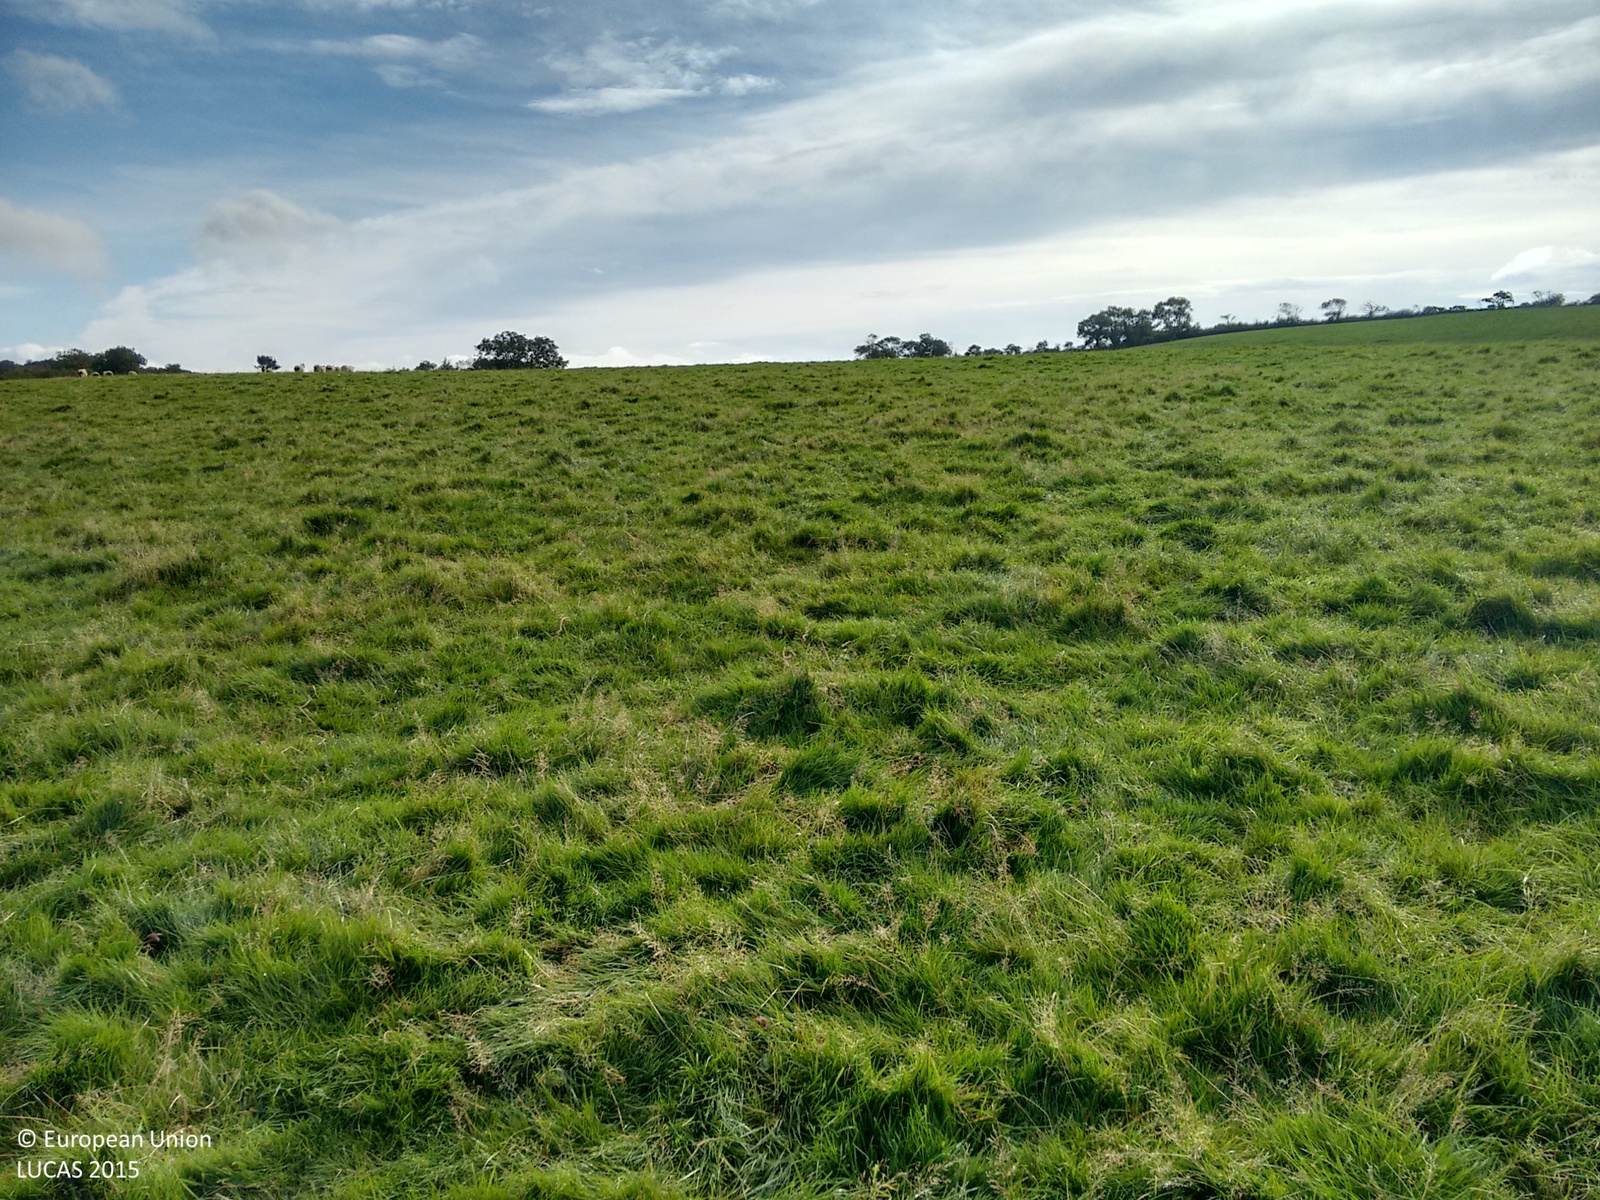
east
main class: Grassland
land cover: Grassland without tree/shrub cover
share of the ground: > 75 %
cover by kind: herbaceous plants 100 %
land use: Agriculture (excluding fallow land and kitchen gardens)
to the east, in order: Grassland without tree/shrub cover; Broadleaved woodland; Fences; Grassland without tree/shrub cover; Broadleaved woodland; Fences; Broadleaved woodland; Rivers and streams
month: September
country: GB
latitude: 50.7155
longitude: -4.4798
